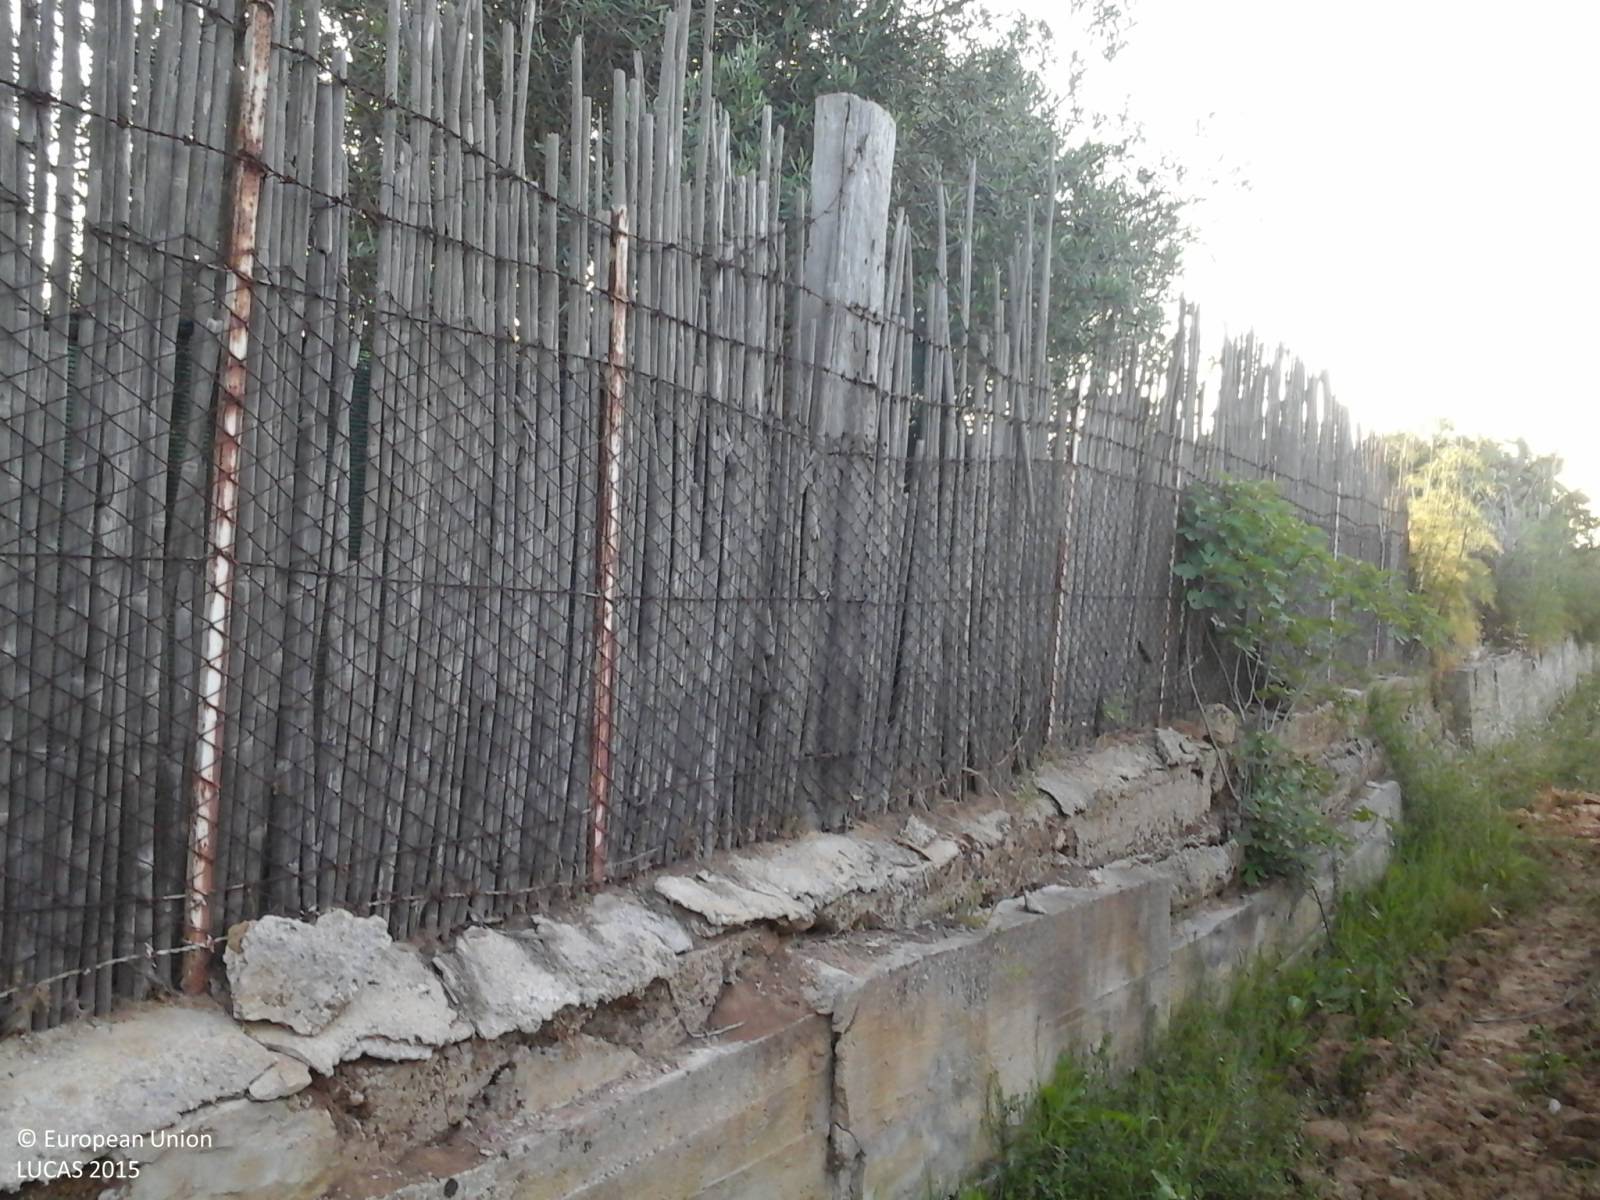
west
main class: Cropland
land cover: Vineyards
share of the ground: 25 - 50 %
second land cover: Olive groves
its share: > 75 %
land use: Agriculture (excluding fallow land and kitchen gardens)
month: June
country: IT
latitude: 38.0069
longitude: 13.0645
